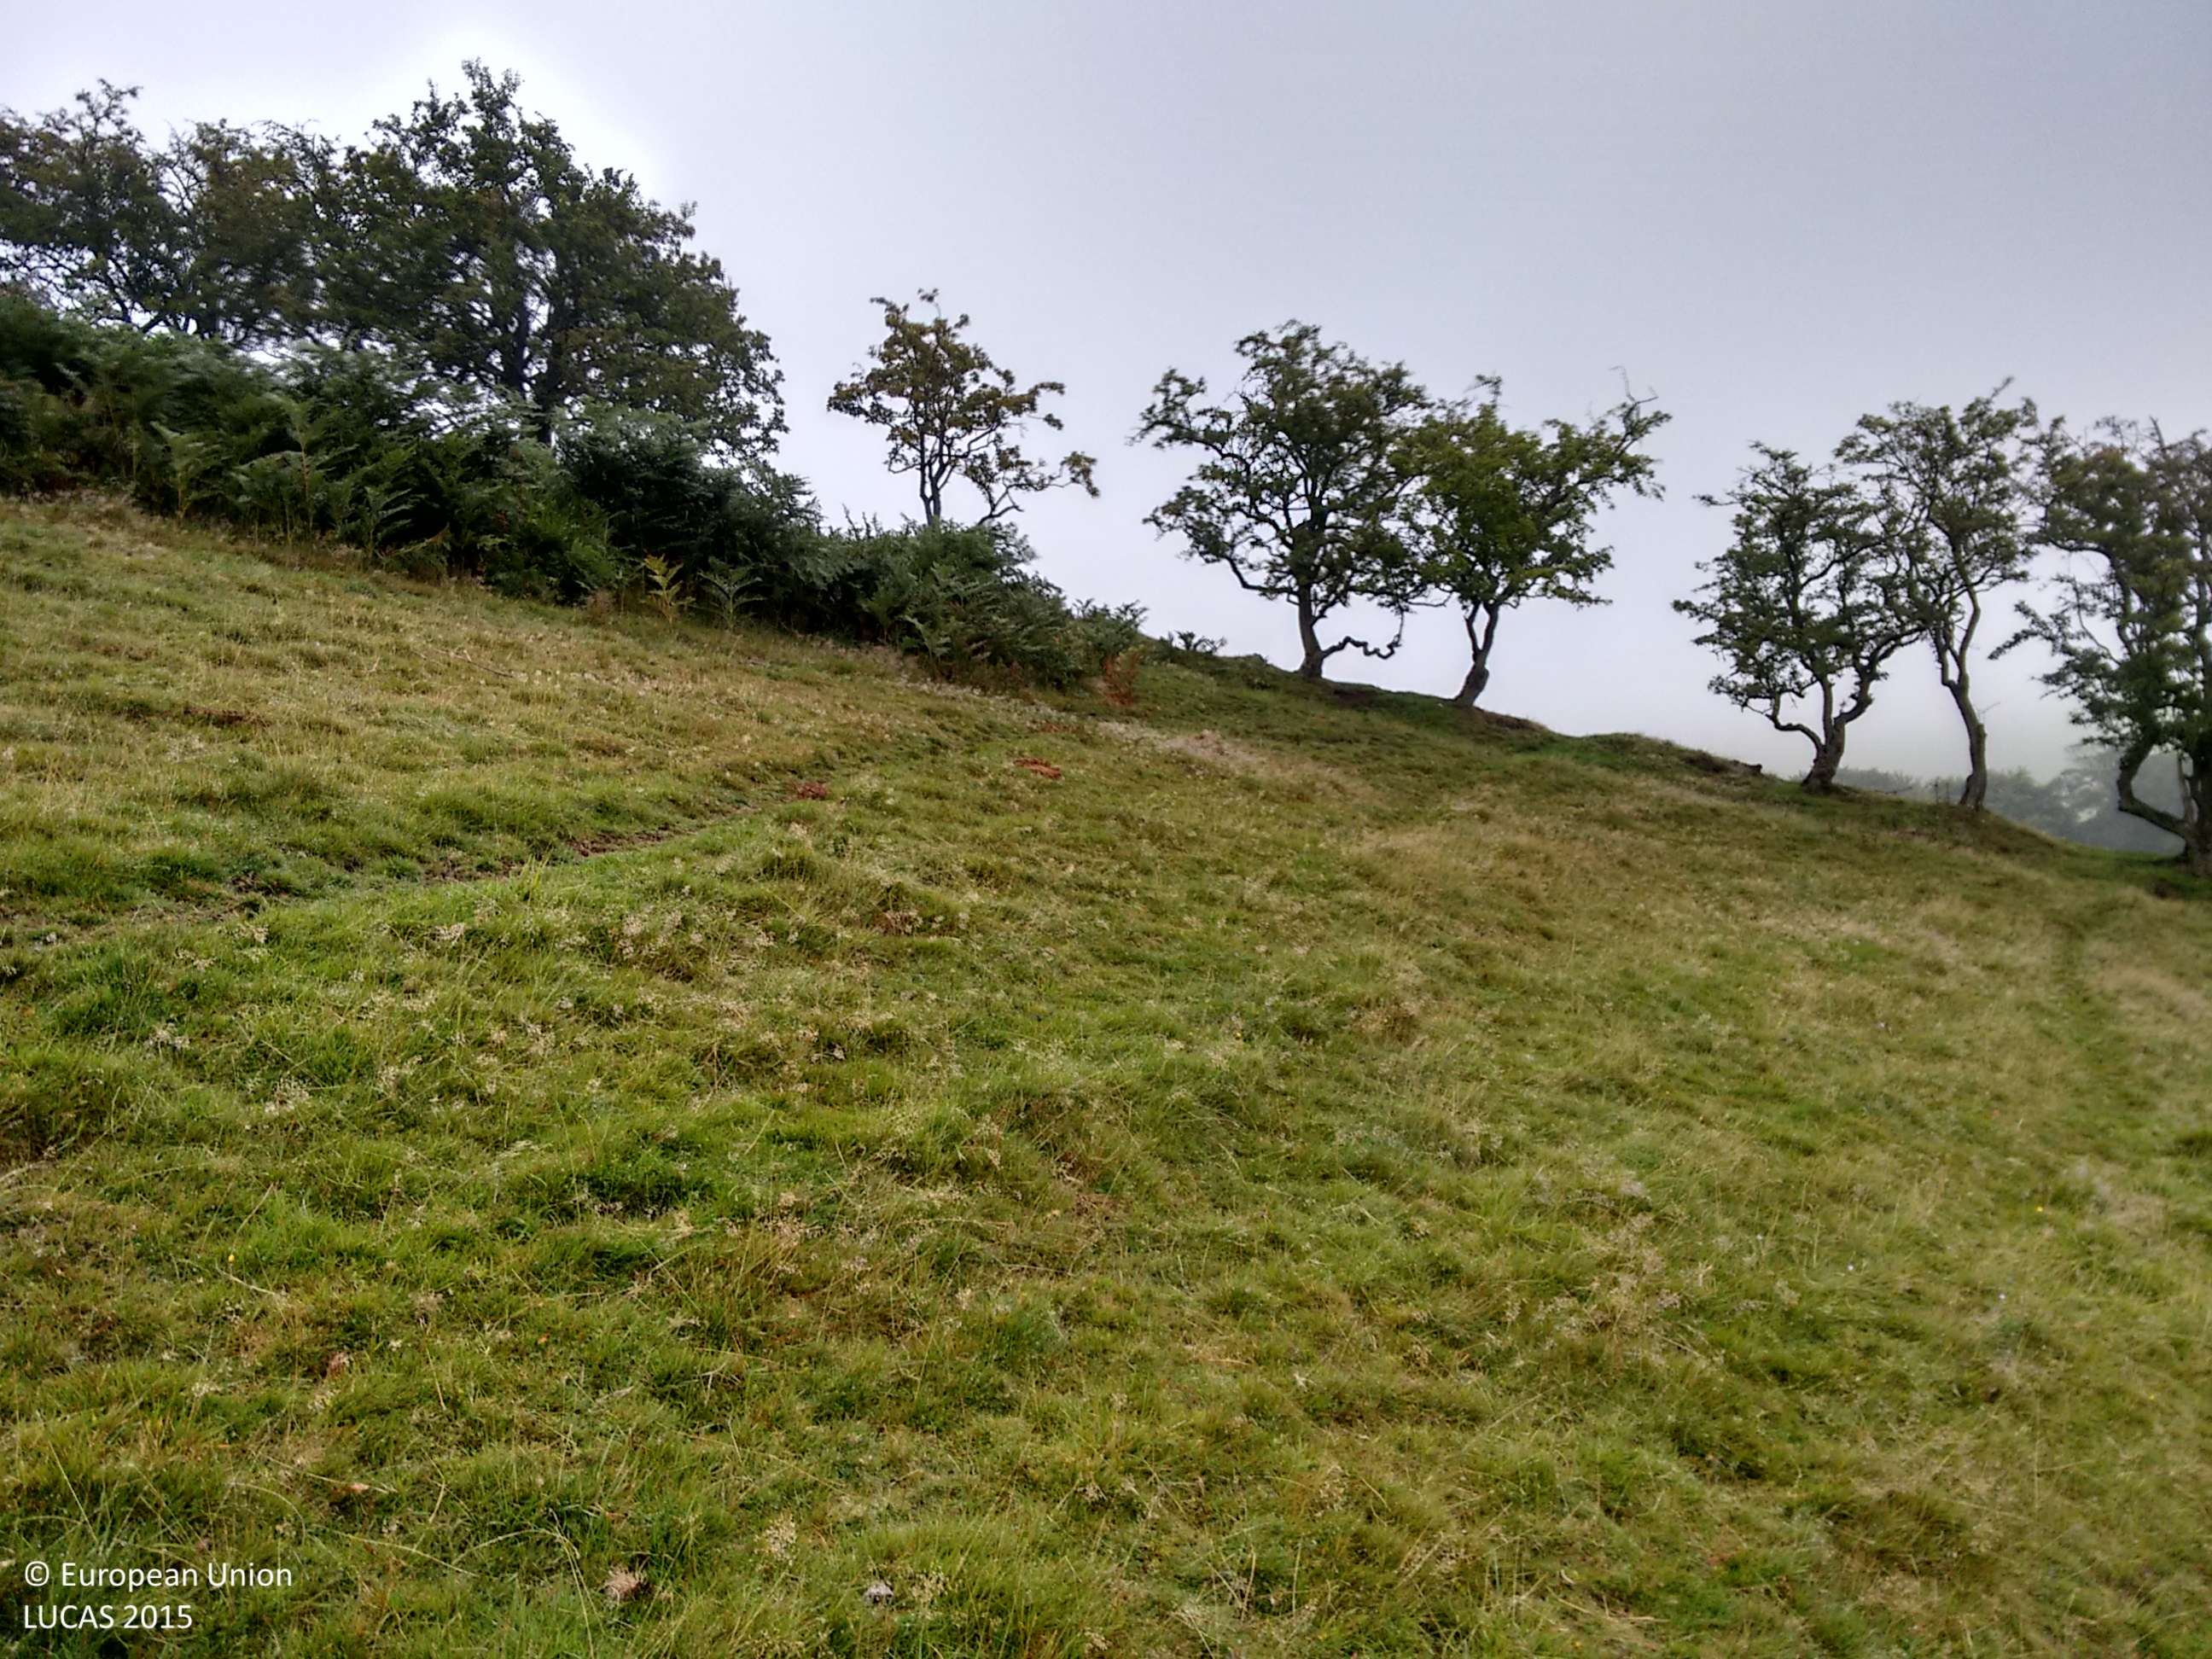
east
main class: Grassland
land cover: Grassland without tree/shrub cover
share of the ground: > 75 %
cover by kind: herbaceous plants 100 %
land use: Agriculture (excluding fallow land and kitchen gardens)
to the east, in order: Grassland without tree/shrub cover; Abandoned hedges; Grassland without tree/shrub cover; Abandoned hedges; Grassland without tree/shrub cover; Fences; Broadleaved woodland
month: September
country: GB
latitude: 52.5633
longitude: -2.8925
